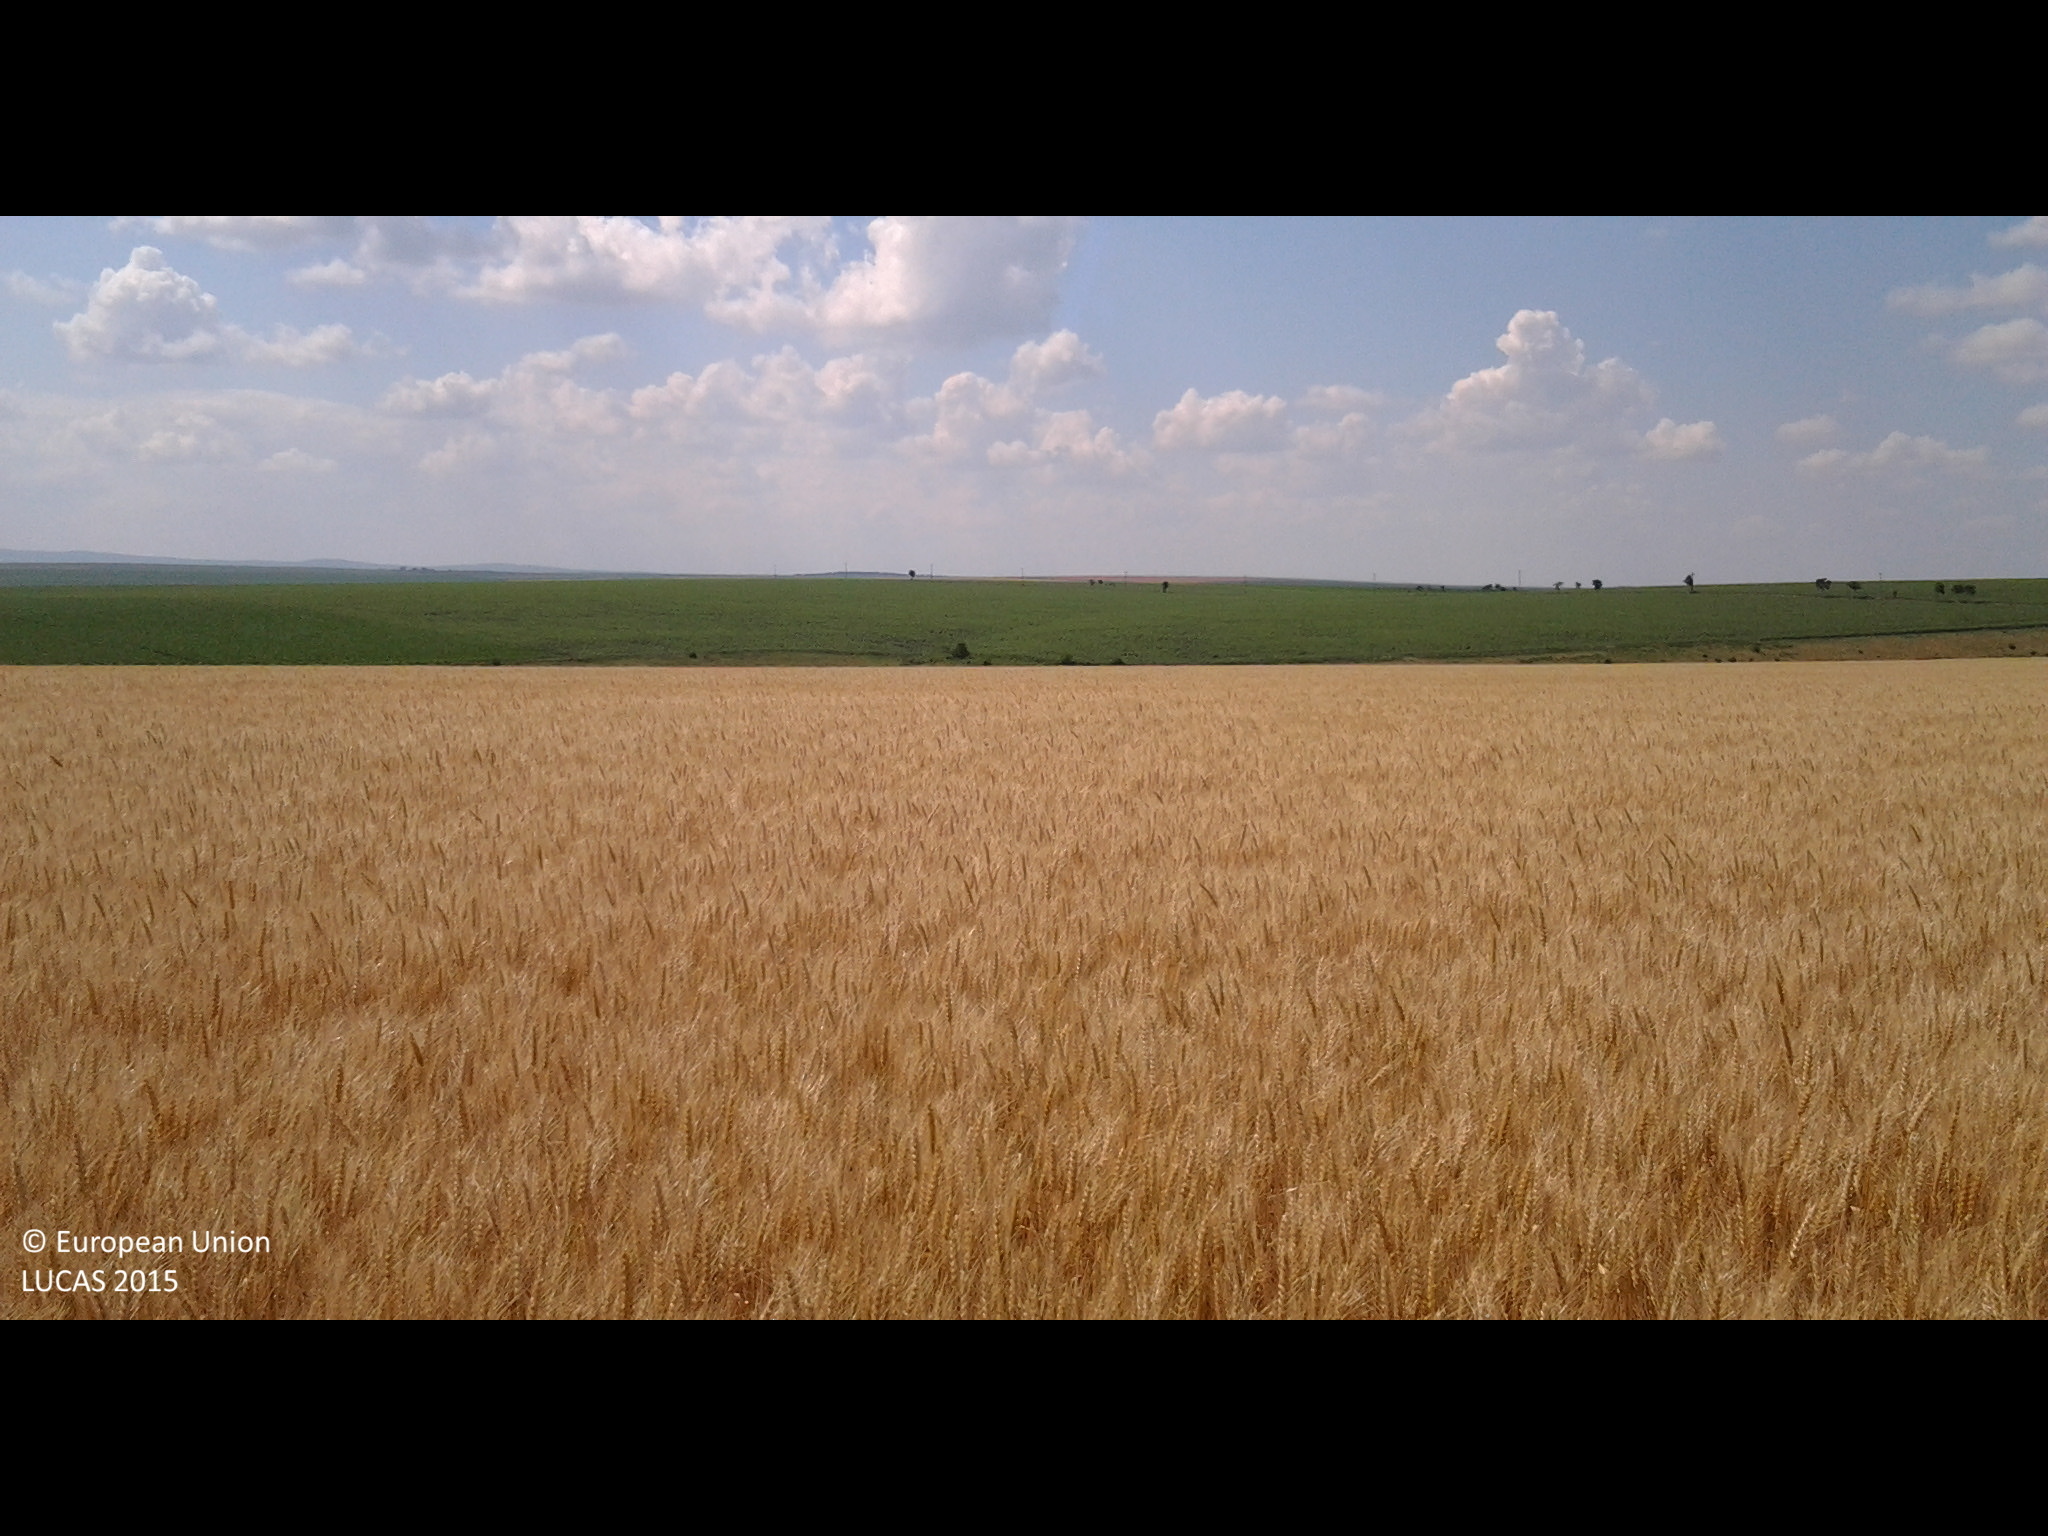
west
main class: Cropland
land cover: Common wheat
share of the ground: > 75 %
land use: Agriculture (excluding fallow land and kitchen gardens)
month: June
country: RO
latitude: 47.5582
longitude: 27.0770
